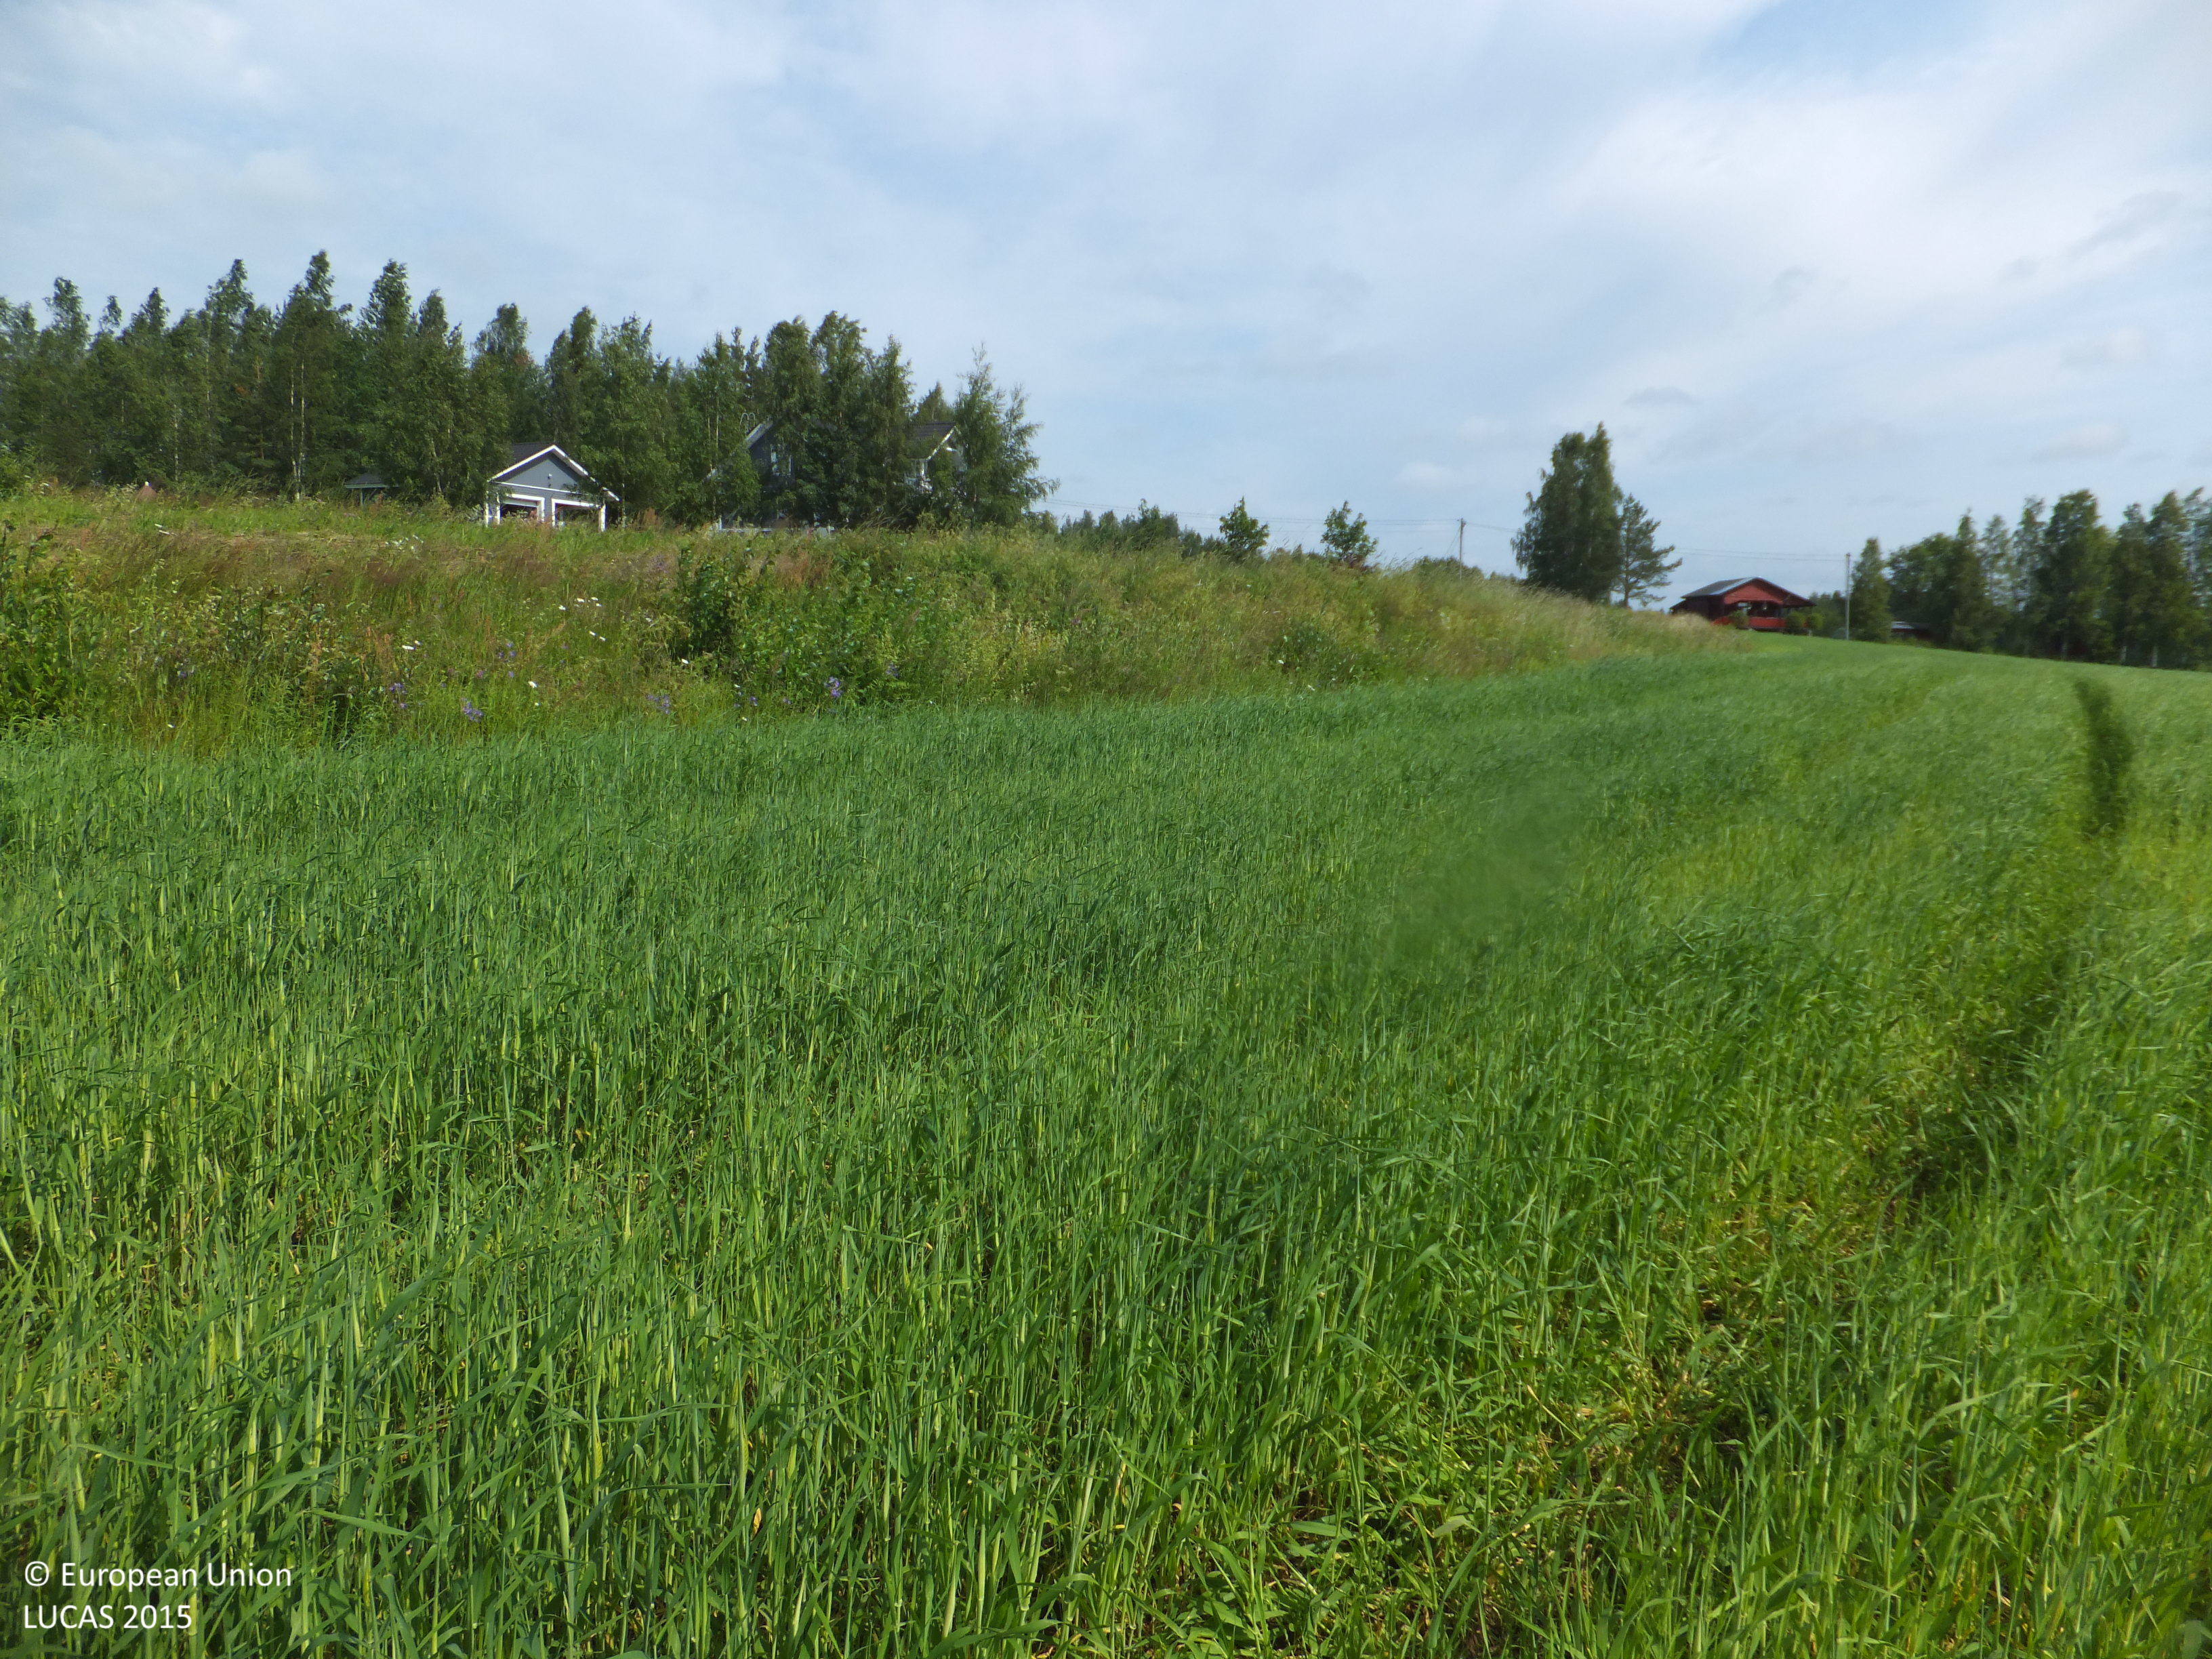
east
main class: Cropland
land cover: Barley
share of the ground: > 75 %
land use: Agriculture (excluding fallow land and kitchen gardens)
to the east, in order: Barley; Grass margins; Ditches and canals; Grass margins; Paved roads, cycling and walking lanes; Grass margins; Ditches and canals; Grass margins; Barley; Paved roads, cycling and walking lanes; Grassland with sparse tree/shrub cover; Temporary grasslands; Electric lines; Temporary grasslands; Ditches and canals; Electric lines; Spontaneously vegetated surfaces; Other mixed woodland
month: July
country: FI
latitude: 63.5748
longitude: 23.1266
